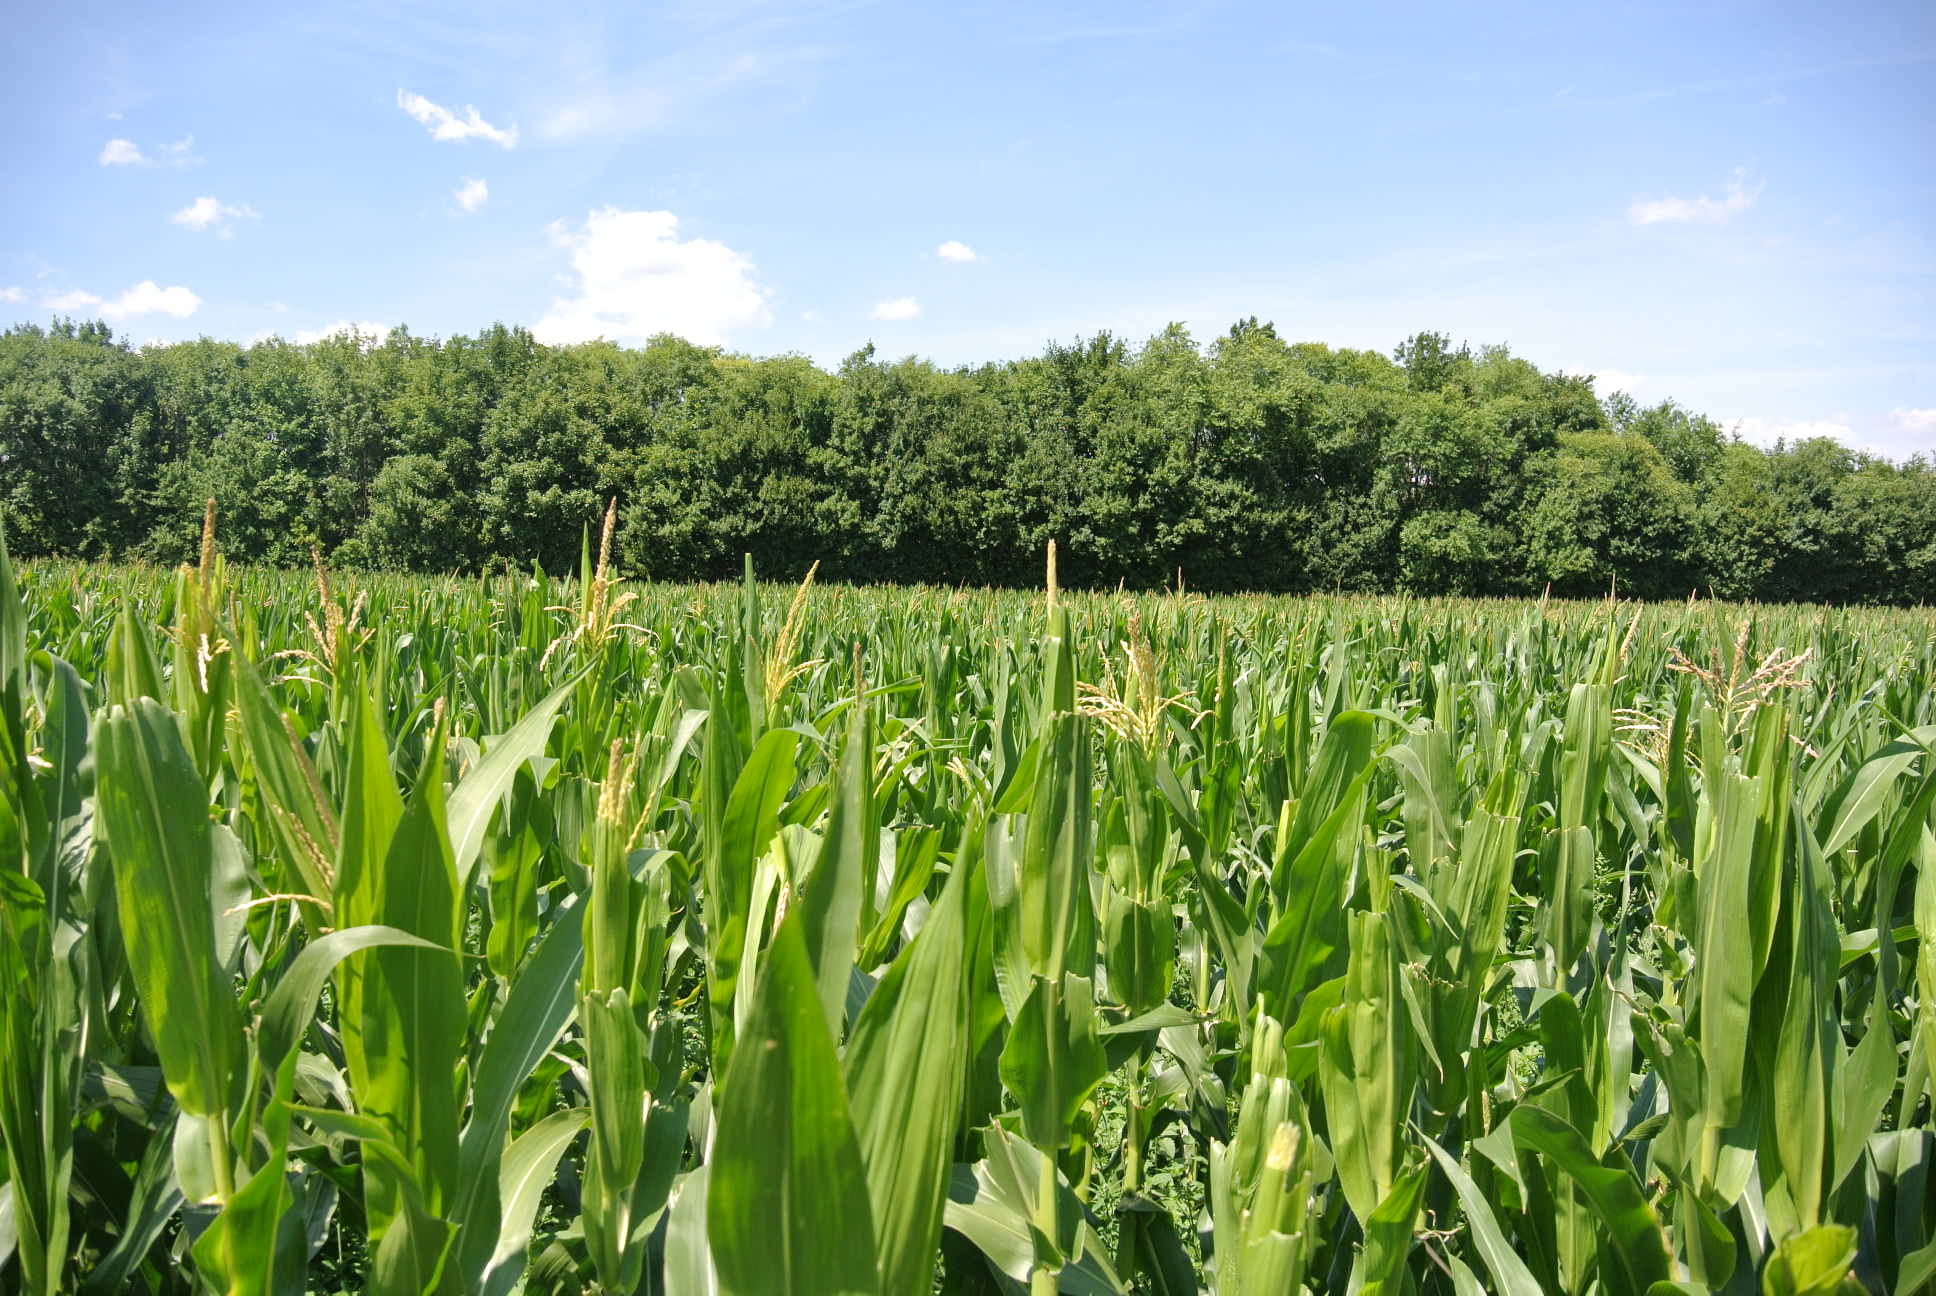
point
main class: Cropland
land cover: Maize
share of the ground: > 75 %
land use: Agriculture (excluding fallow land and kitchen gardens)
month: July
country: AT
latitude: 47.7296
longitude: 16.4174
